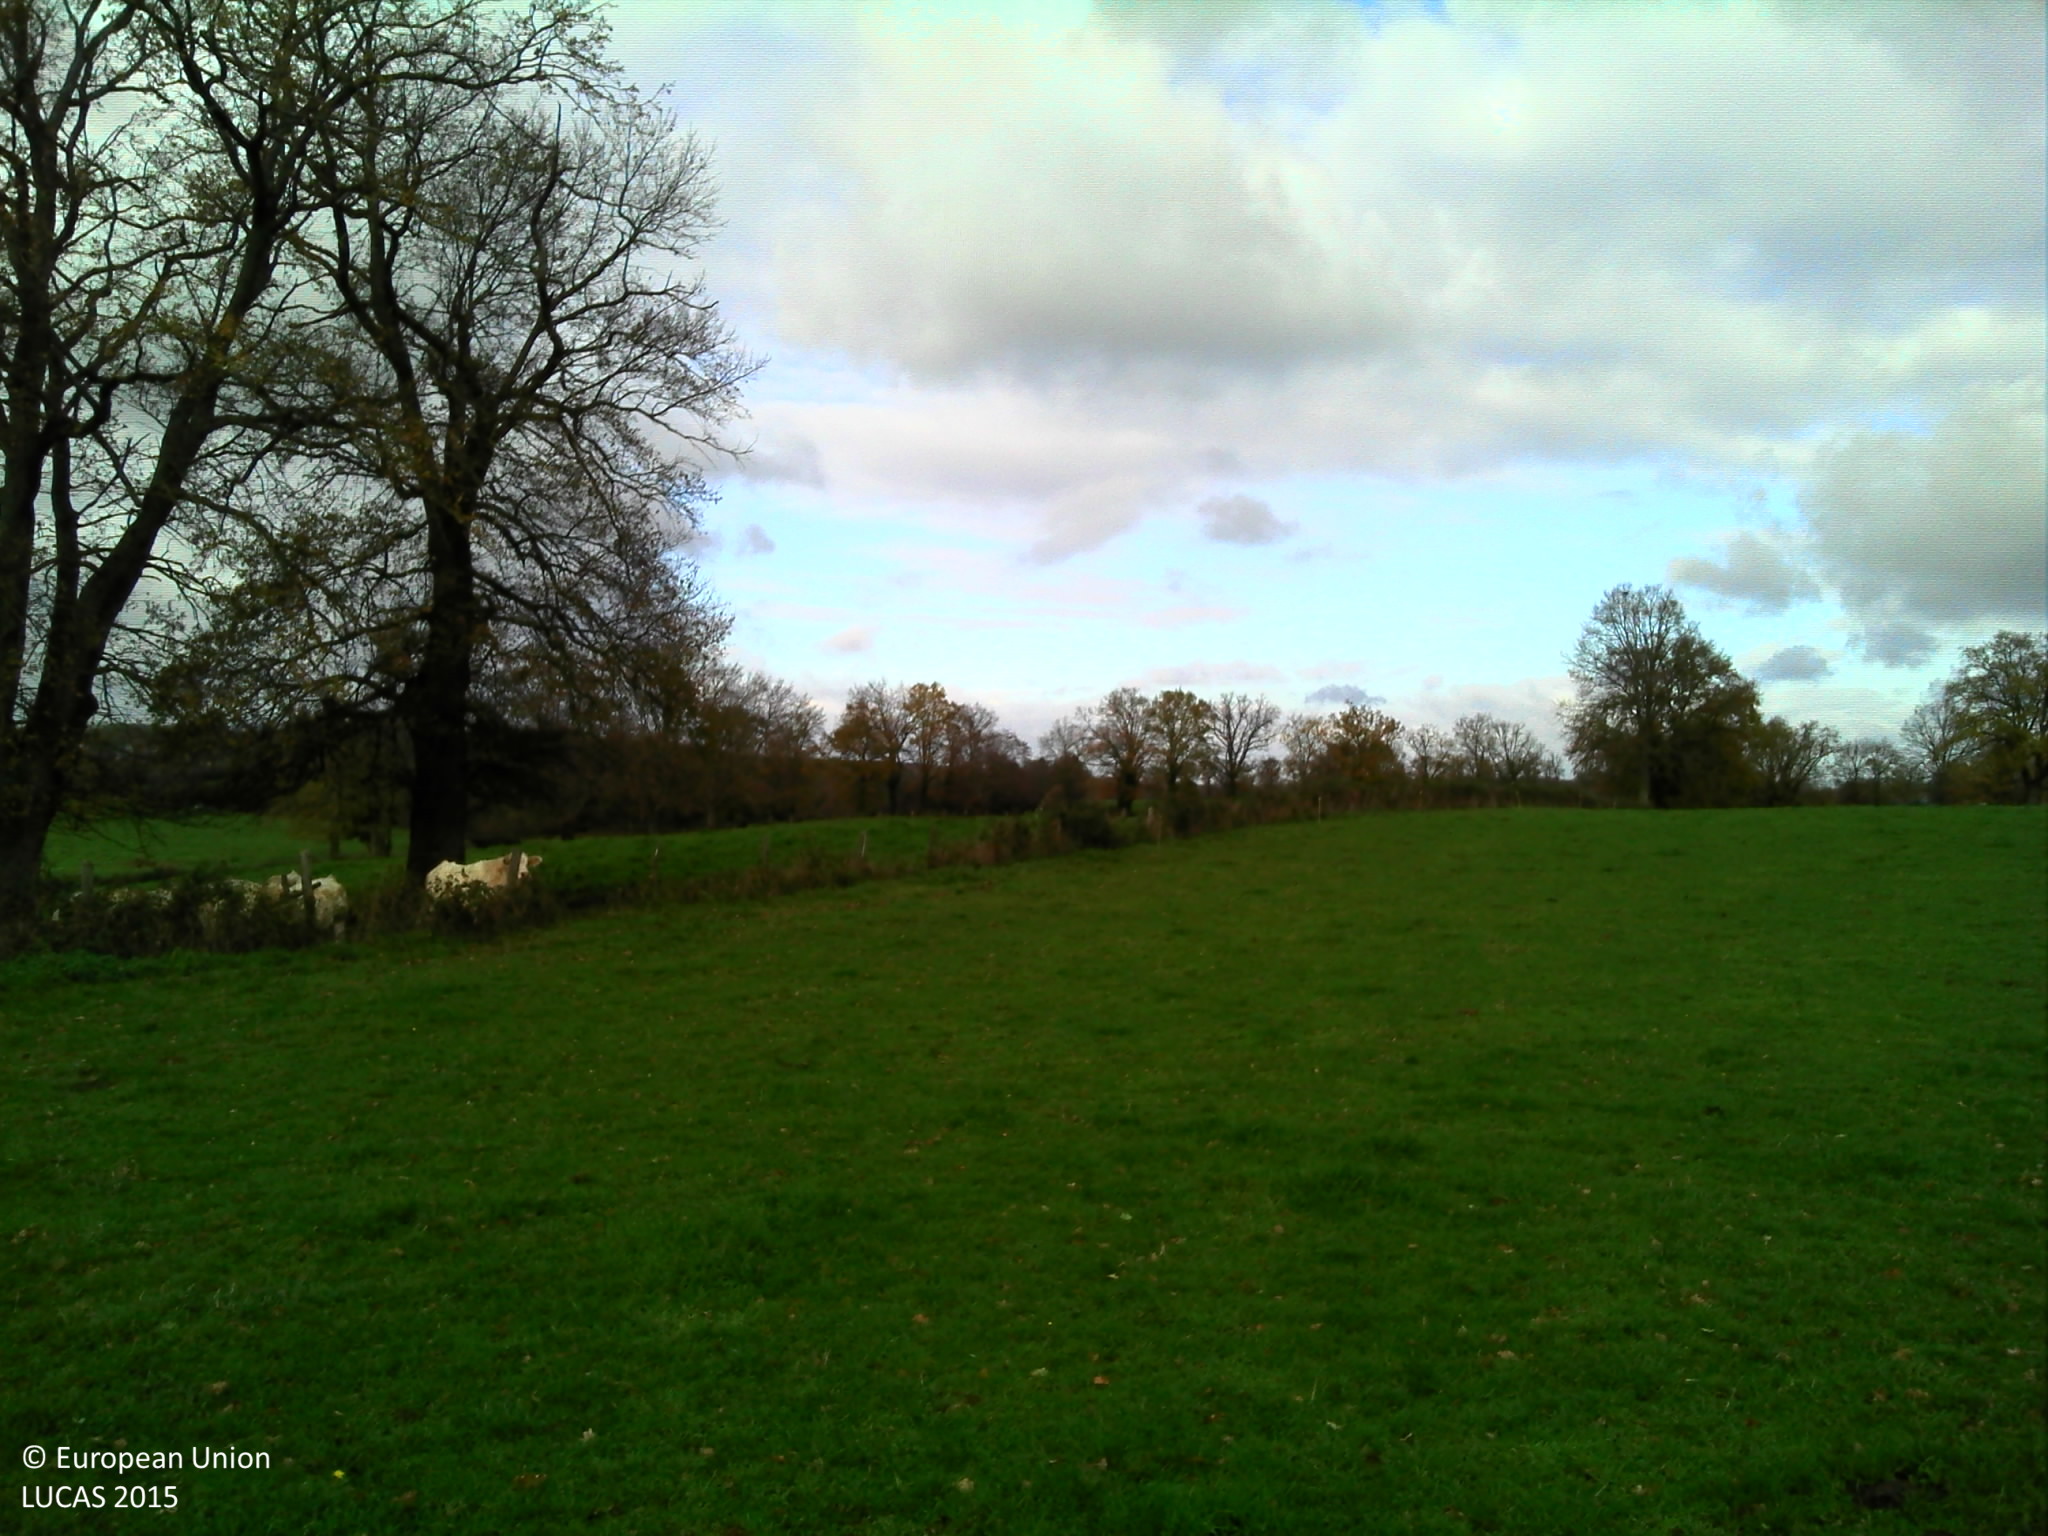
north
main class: Grassland
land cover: Grassland without tree/shrub cover
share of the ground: > 75 %
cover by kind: herbaceous plants 100 %
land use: Agriculture (excluding fallow land and kitchen gardens)
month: November
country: FR
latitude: 46.4177
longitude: 3.6895
